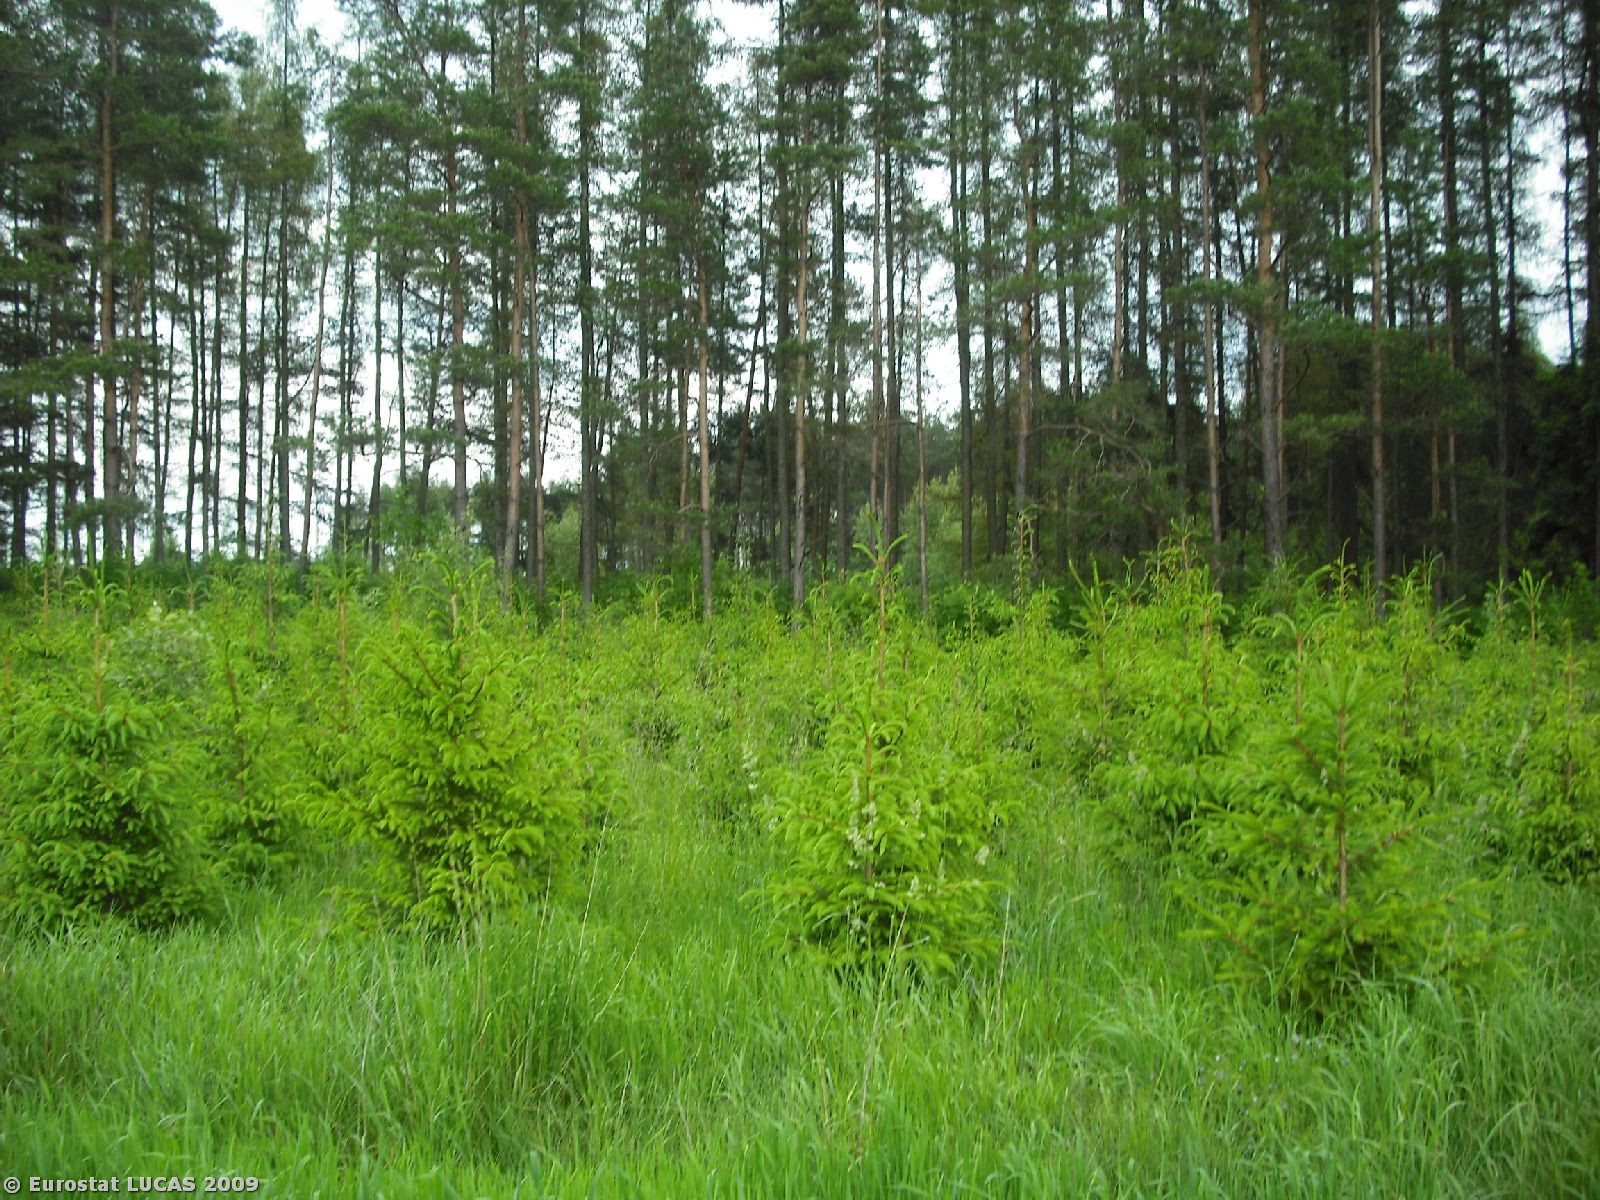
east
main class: Cropland
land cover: Oats
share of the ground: > 75 %
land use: Agriculture (excluding fallow land and kitchen gardens)
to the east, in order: Oats; Grass margins; Coniferous woodland; Tracks; Coniferous woodland
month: June
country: PL
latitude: 54.1732
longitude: 22.8311
